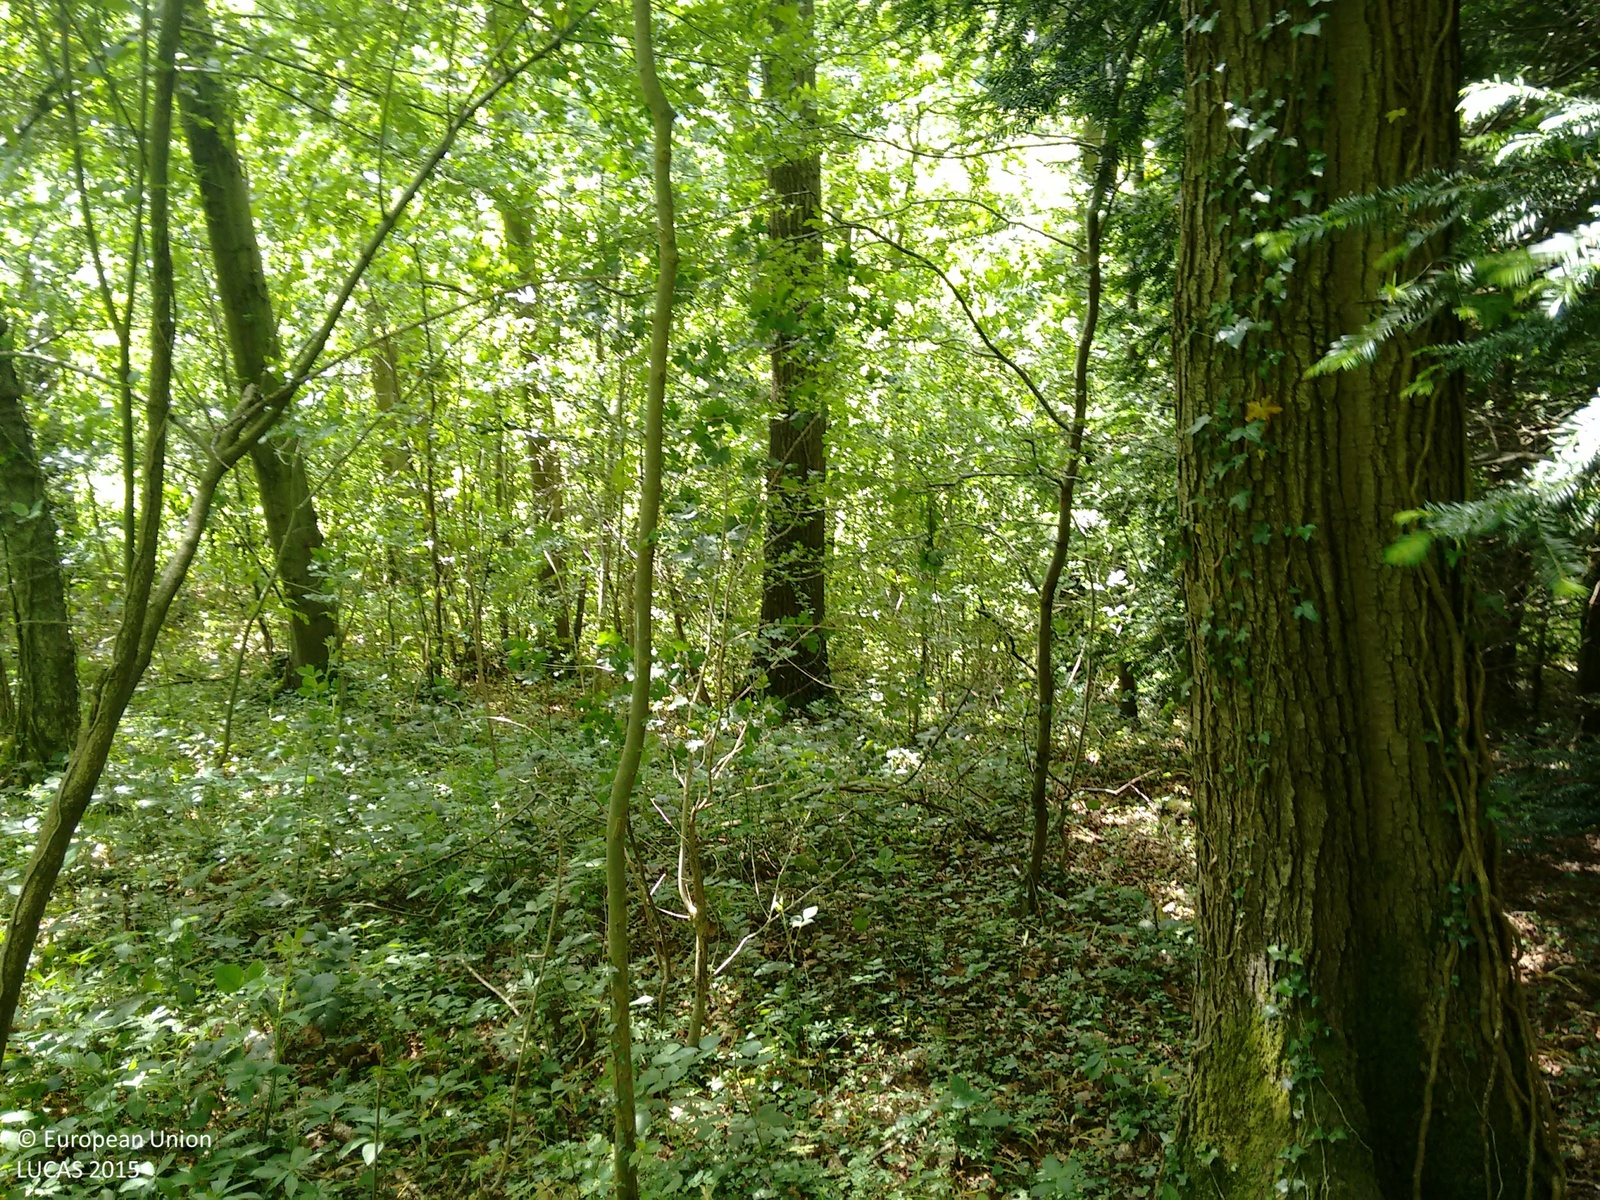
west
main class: Woodland
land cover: Broadleaved woodland
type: mesophytic deciduous forest
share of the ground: > 75 %
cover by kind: broadleaved forest trees 100 %
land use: Semi-natural and natural areas not in use
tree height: > 5 m
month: June
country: GB
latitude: 52.1445
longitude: -2.3833
